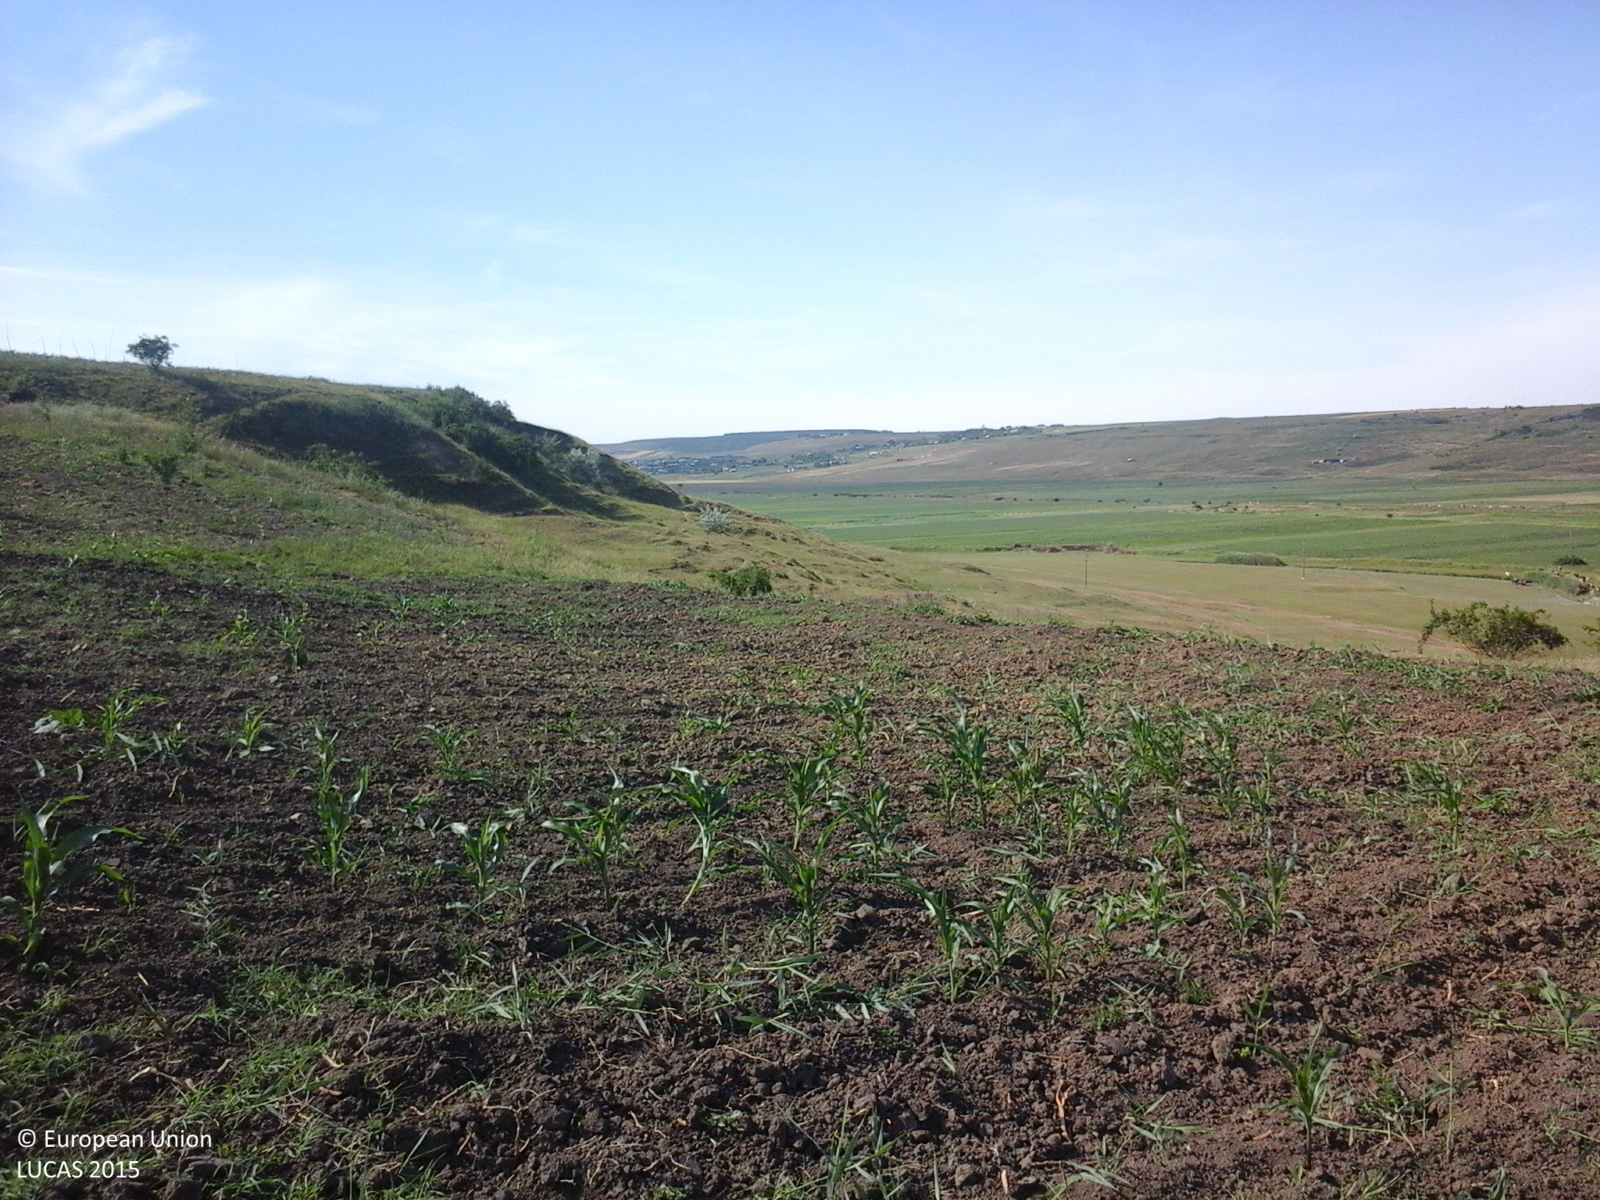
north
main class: Cropland
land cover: Maize
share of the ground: 25 - 50 %
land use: Agriculture (excluding fallow land and kitchen gardens)
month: June
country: RO
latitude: 47.3056
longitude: 27.0464
